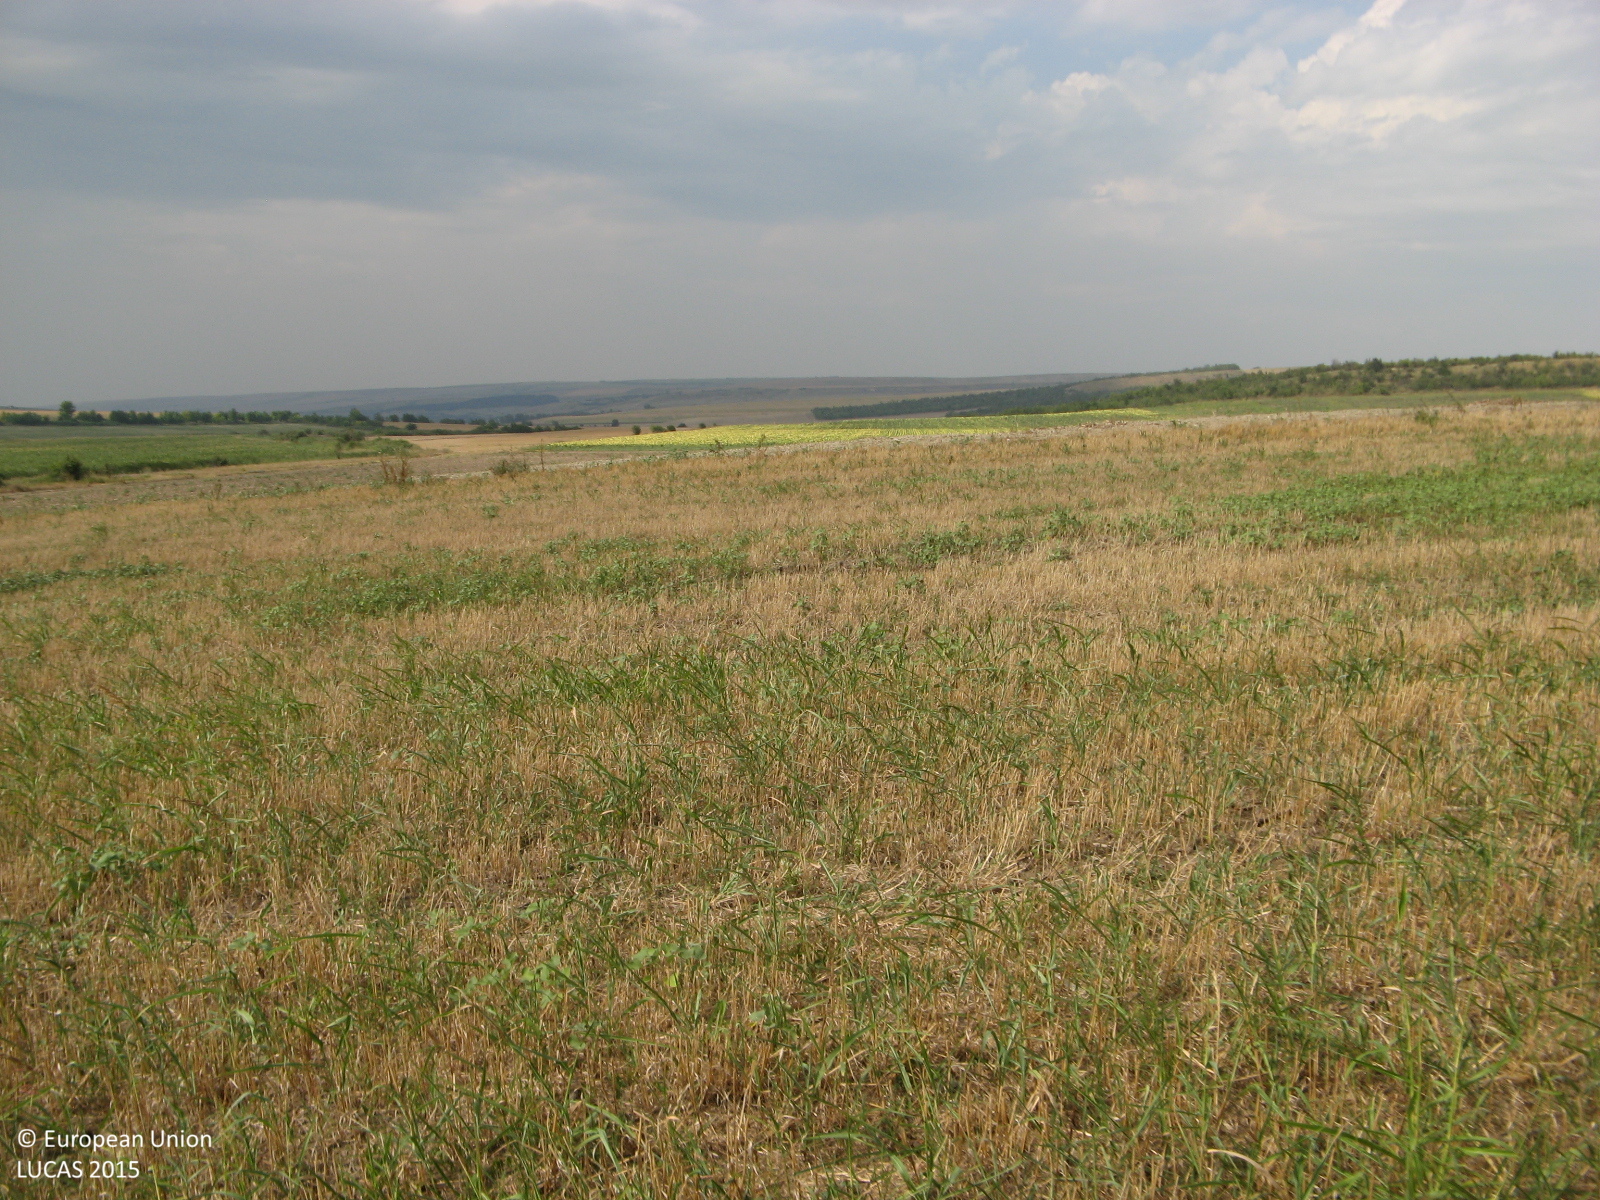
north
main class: Cropland
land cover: Common wheat
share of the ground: 50 - 75 %
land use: Agriculture (excluding fallow land and kitchen gardens)
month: August
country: BG
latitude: 43.4694
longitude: 25.2683
